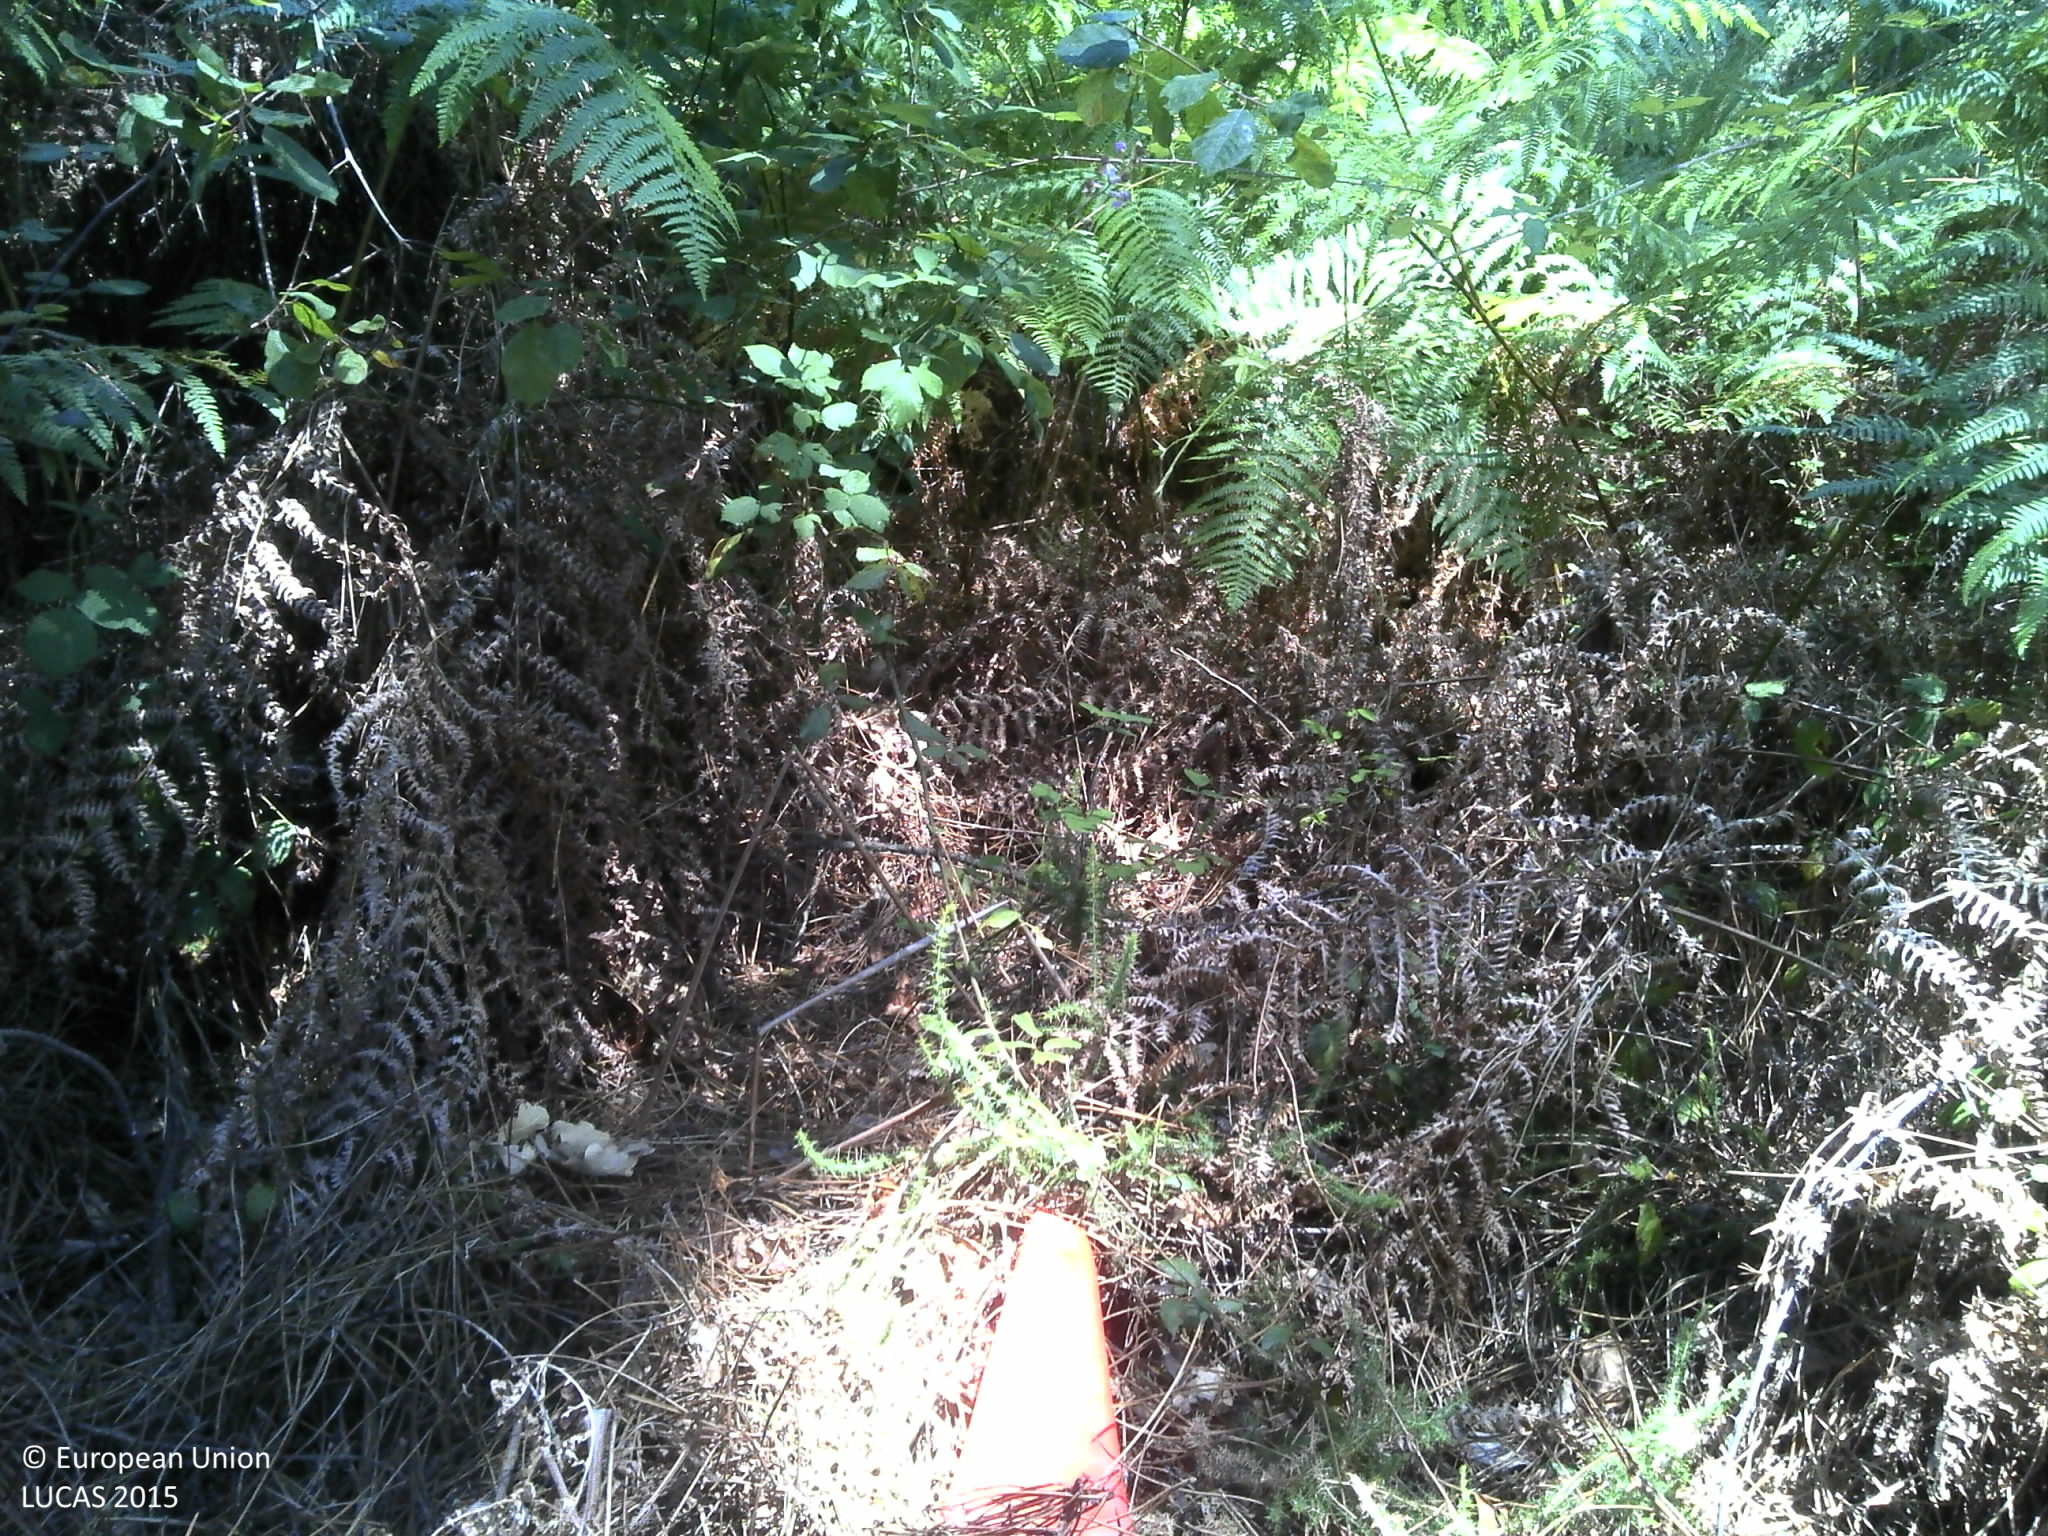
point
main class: Woodland
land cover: Pine dominated coniferous woodland
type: coniferous forest of the mediterranean region
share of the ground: 50 - 75 %
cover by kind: coniferous forest trees 60 %, shrubs 25 %, unconsolidated bare surface 10 %, herbaceous plants 5 %
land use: Forestry
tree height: > 5 m
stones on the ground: < 10 %
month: June
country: PT
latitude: 40.5606
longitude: -8.0183
